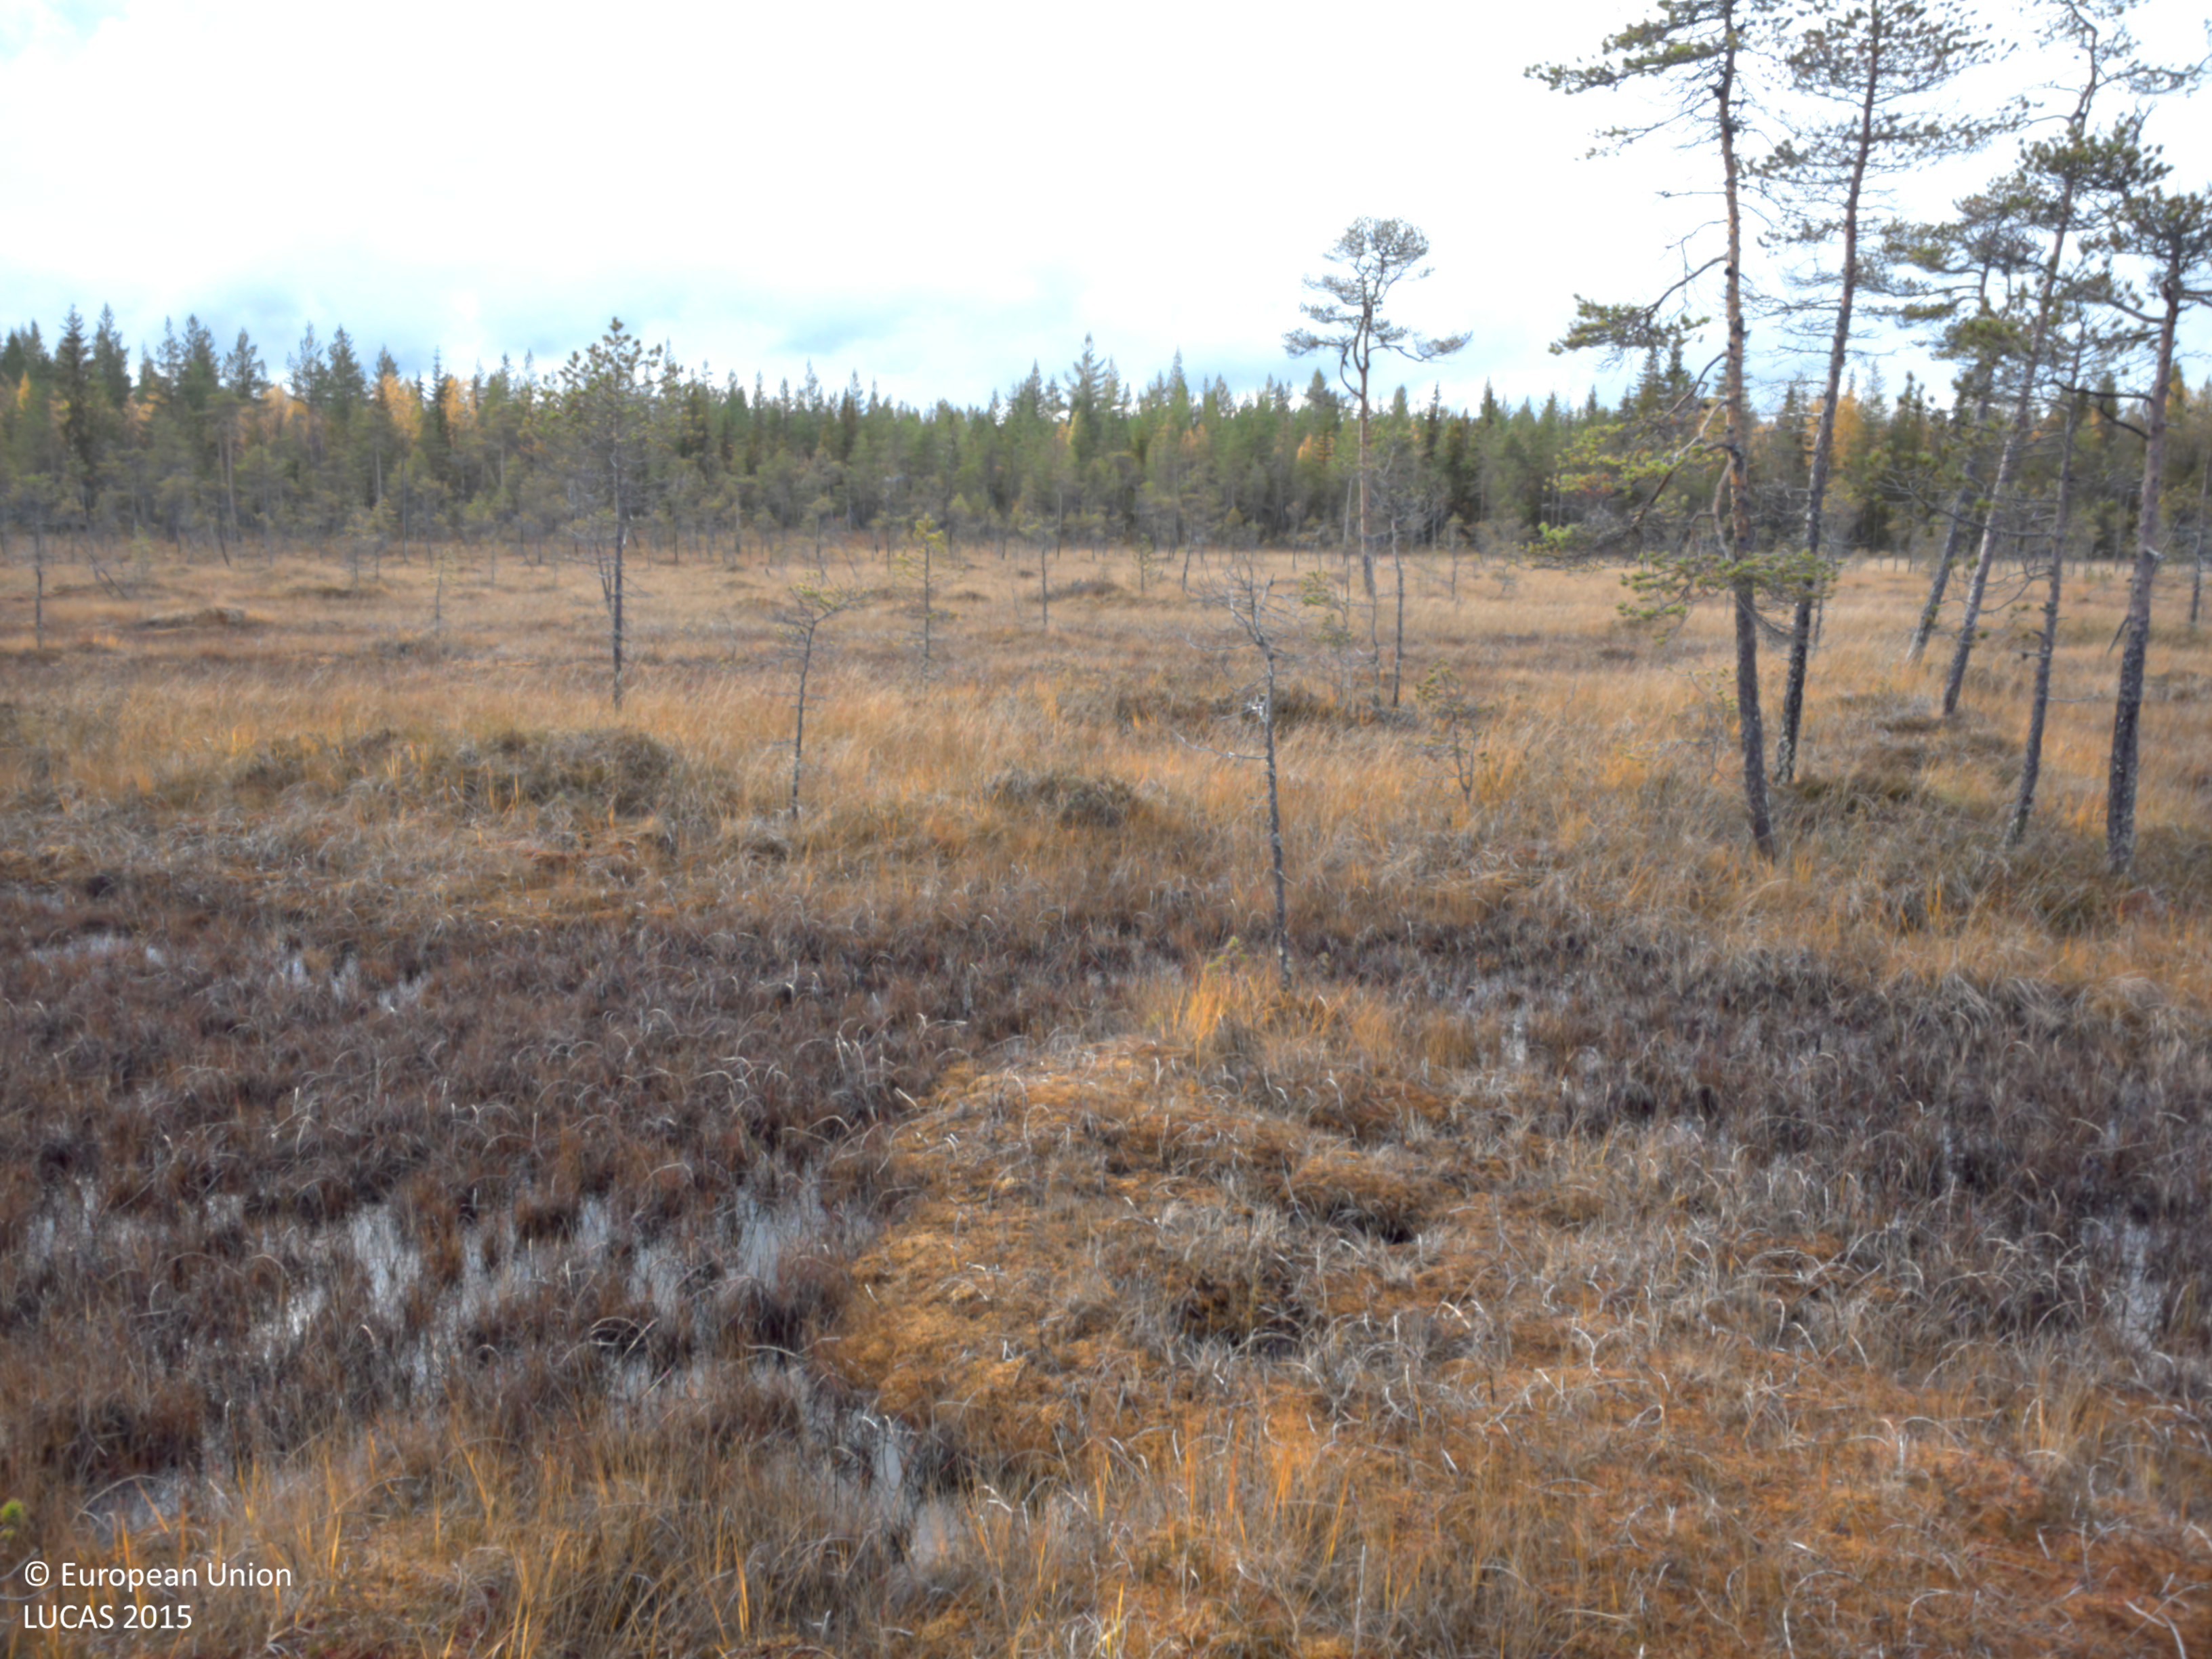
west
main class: Woodland
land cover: Pine dominated coniferous woodland
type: boreal forest
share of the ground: 25 - 50 %
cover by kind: coniferous forest trees 50 %, shrubs 20 %, herbaceous plants 15 %, lichens and mosses 15 %
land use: Semi-natural and natural areas not in use
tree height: < 5 m
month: September
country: SE
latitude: 64.7262
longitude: 18.9733
